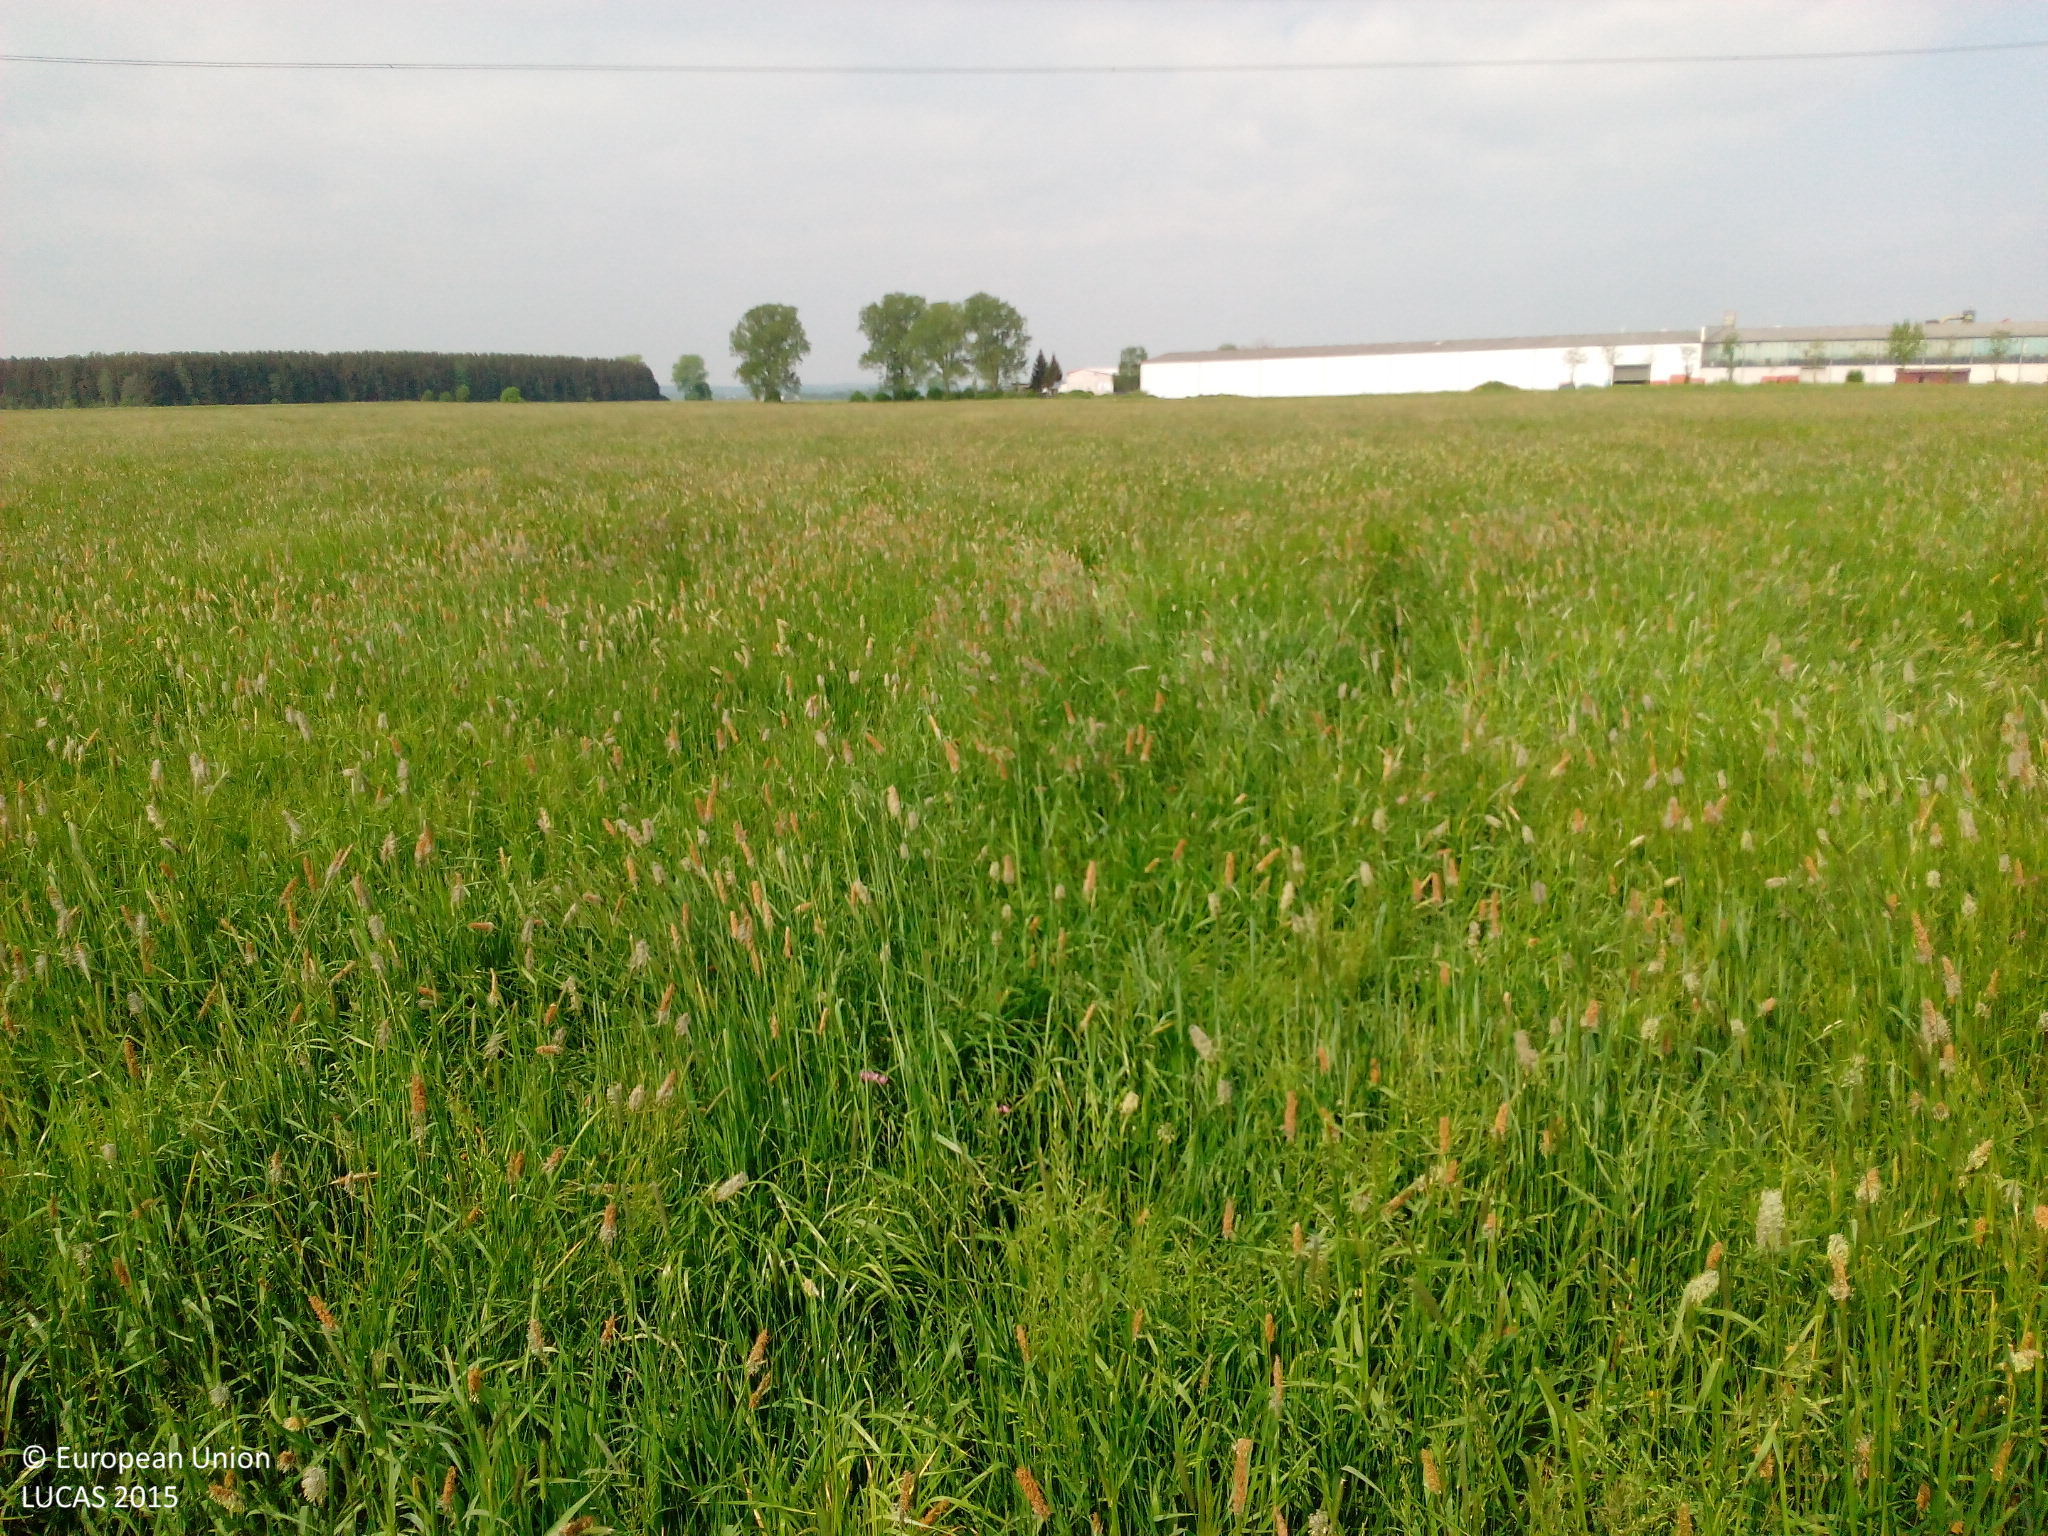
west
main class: Grassland
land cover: Grassland without tree/shrub cover
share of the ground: > 75 %
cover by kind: herbaceous plants 100 %
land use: Agriculture (excluding fallow land and kitchen gardens)
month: May
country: DE
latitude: 48.0601
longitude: 9.4234
